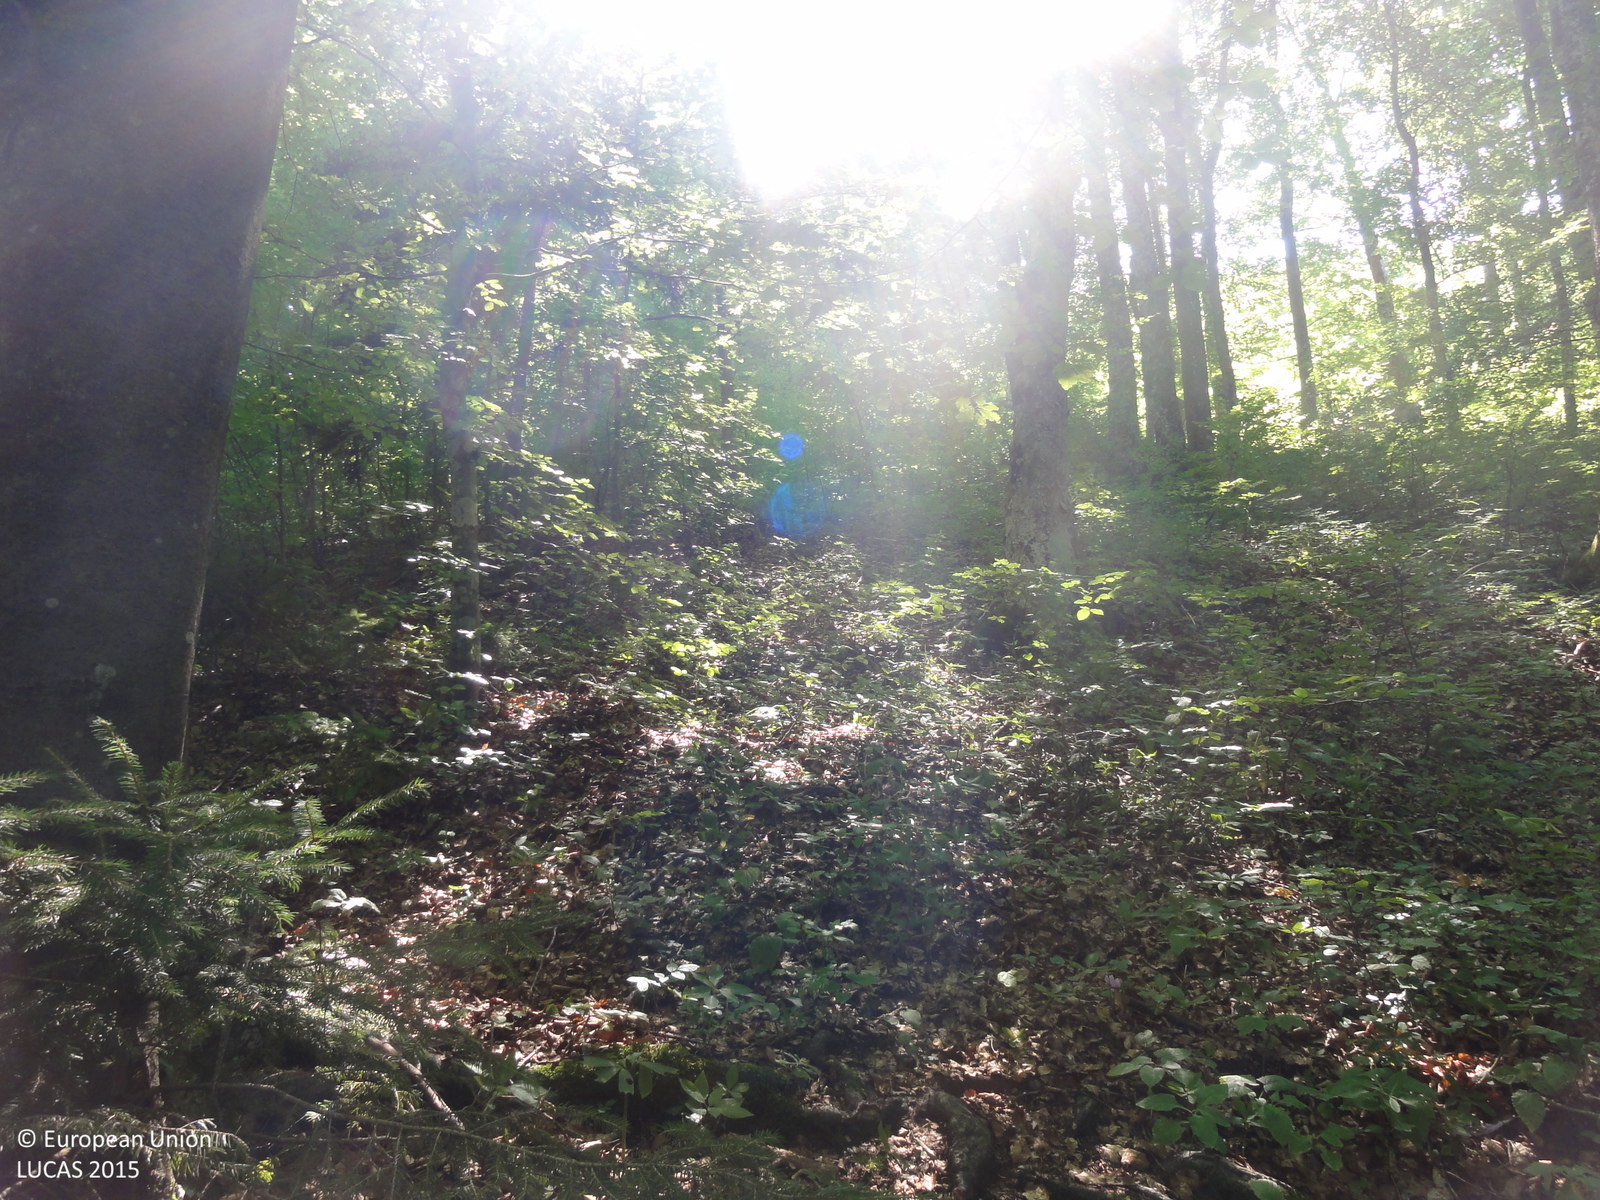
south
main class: Woodland
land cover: Broadleaved woodland
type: mountainous beech forest
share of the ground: > 75 %
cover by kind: broadleaved forest trees 100 %
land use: Forestry
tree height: > 5 m
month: August
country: SI
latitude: 46.0515
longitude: 15.0504
